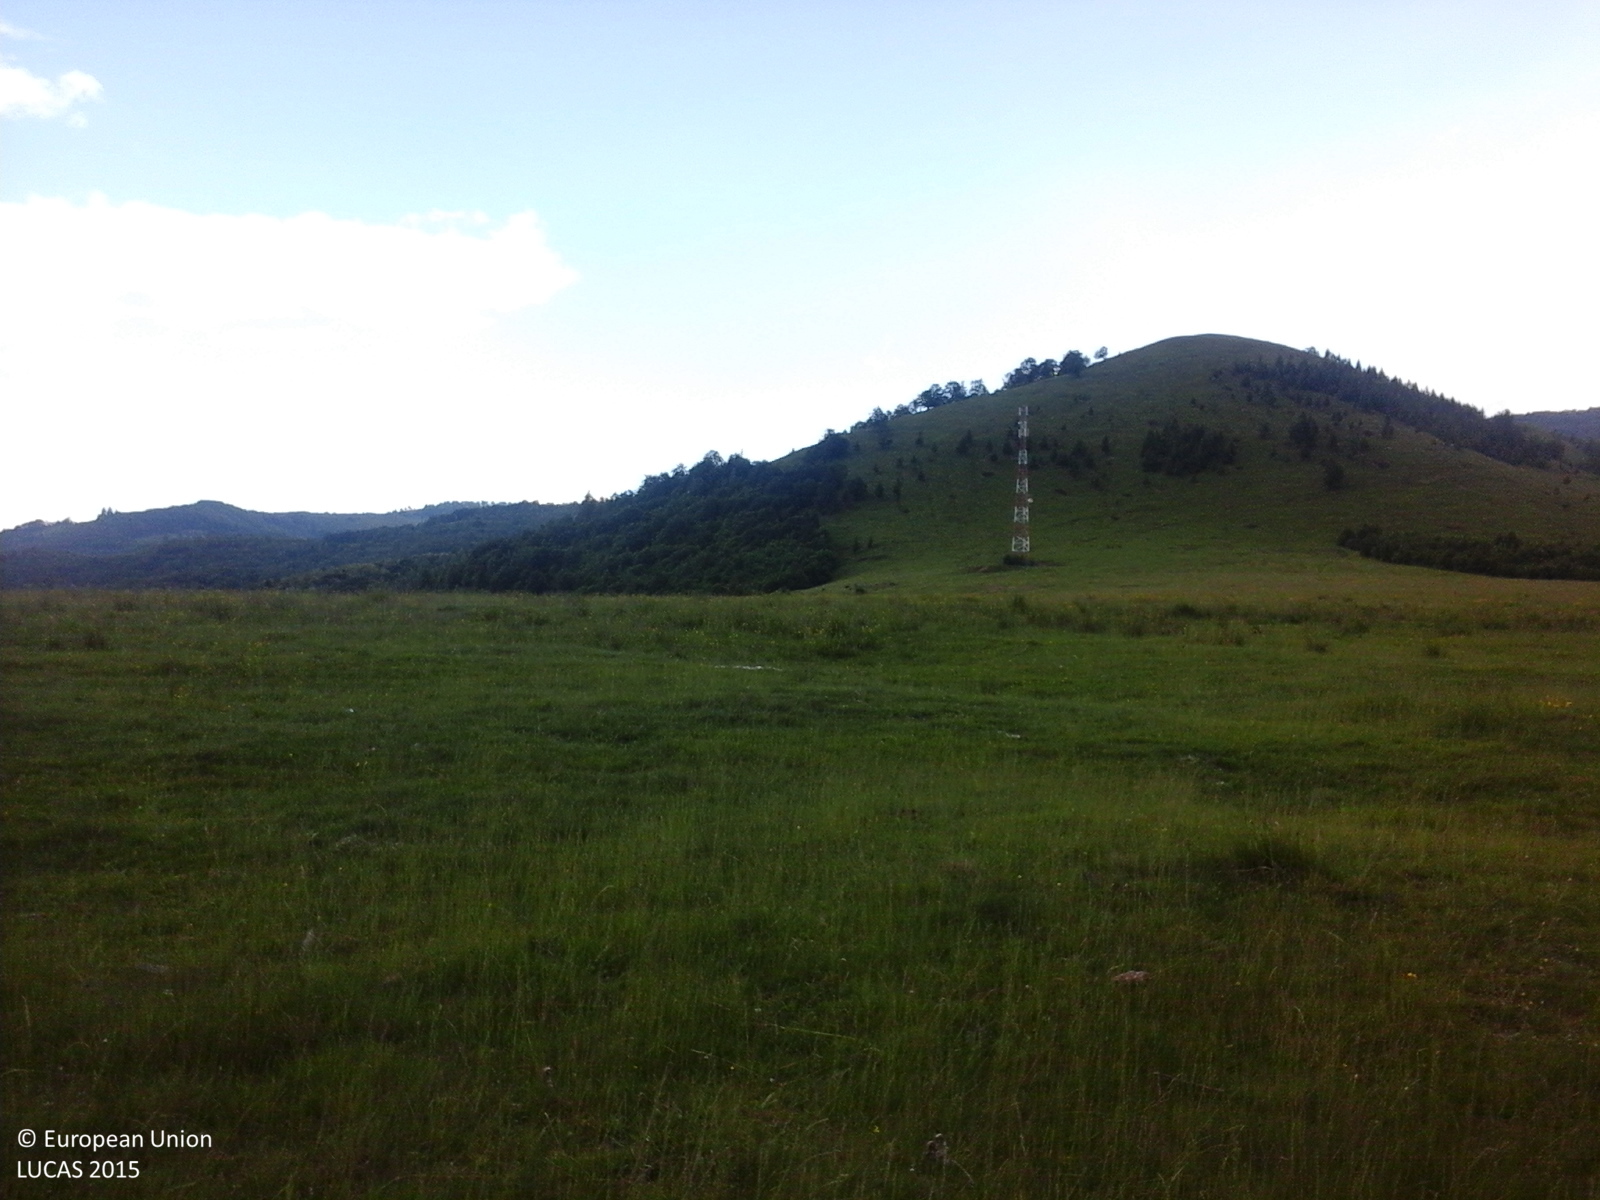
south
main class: Grassland
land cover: Grassland without tree/shrub cover
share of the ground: > 75 %
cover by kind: herbaceous plants 100 %
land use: Agriculture (excluding fallow land and kitchen gardens)
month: May
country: RO
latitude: 45.6913
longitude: 25.2363
